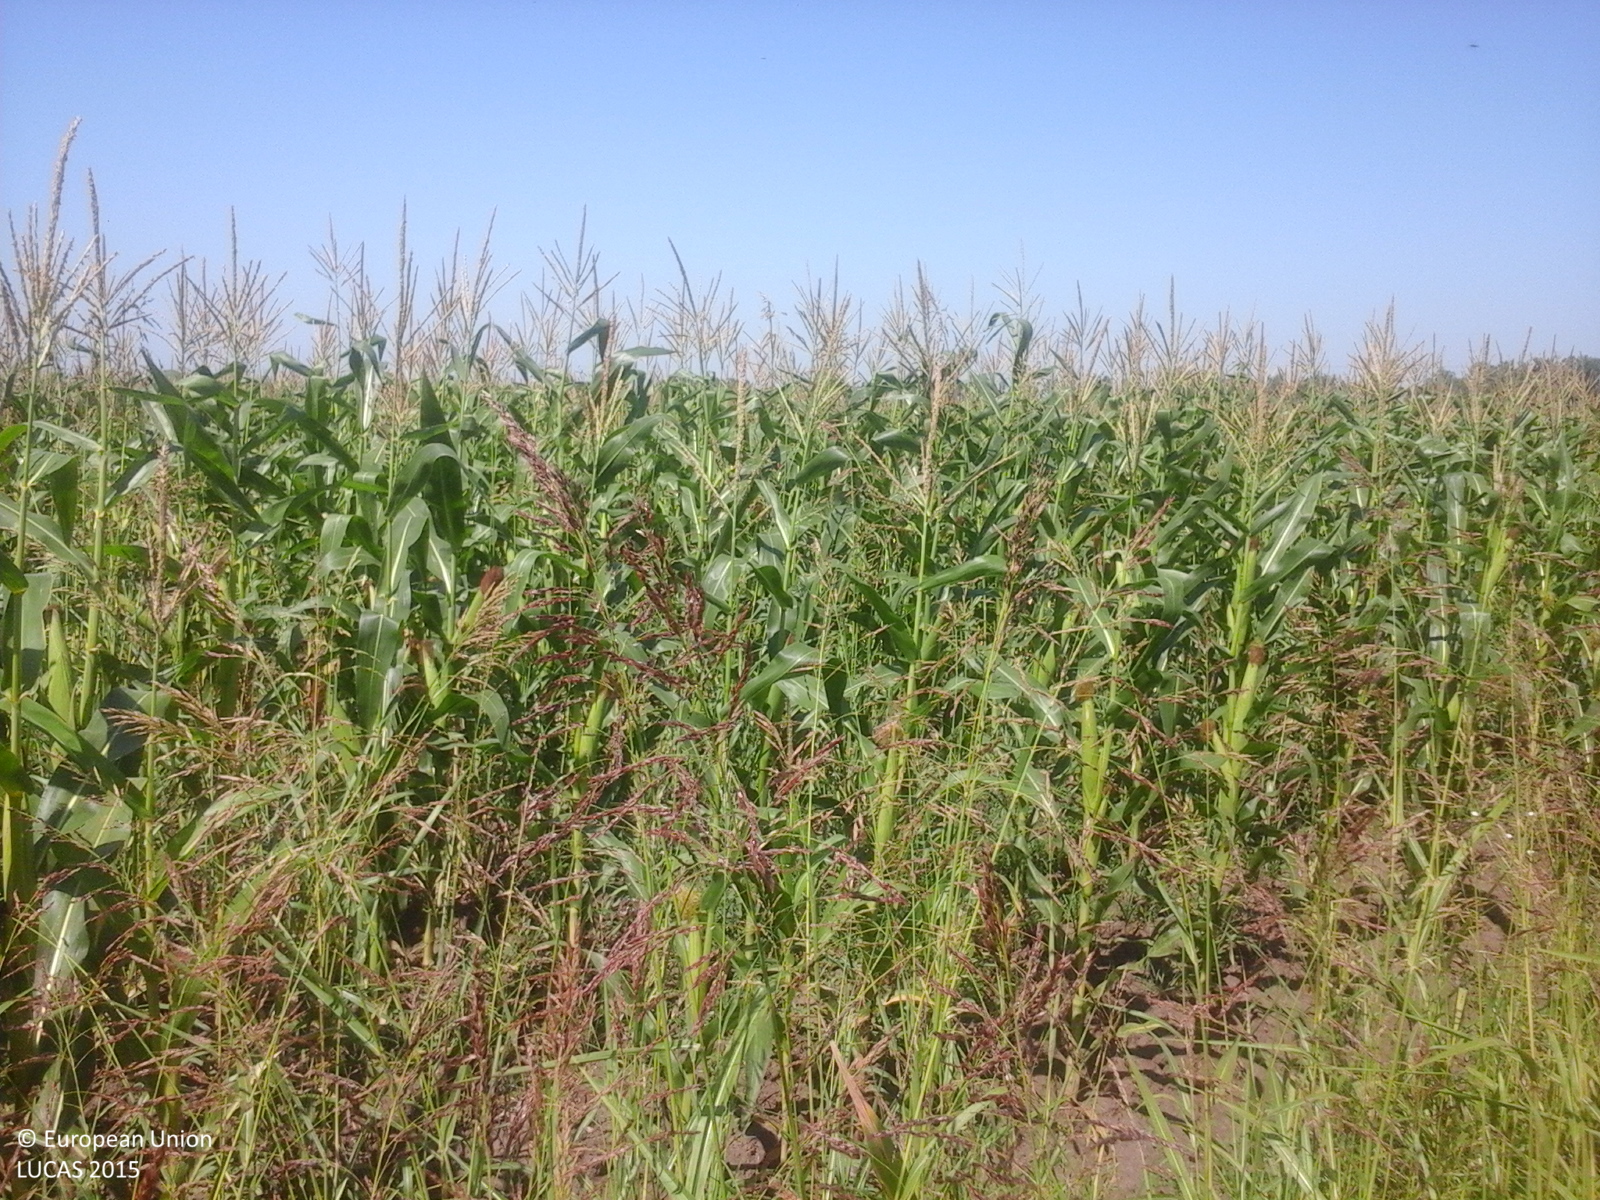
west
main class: Grassland
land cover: Spontaneously vegetated surfaces
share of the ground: 50 - 75 %
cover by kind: herbaceous plants 100 %
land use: Fallow land
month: July
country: RO
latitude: 44.2331
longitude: 26.6044
